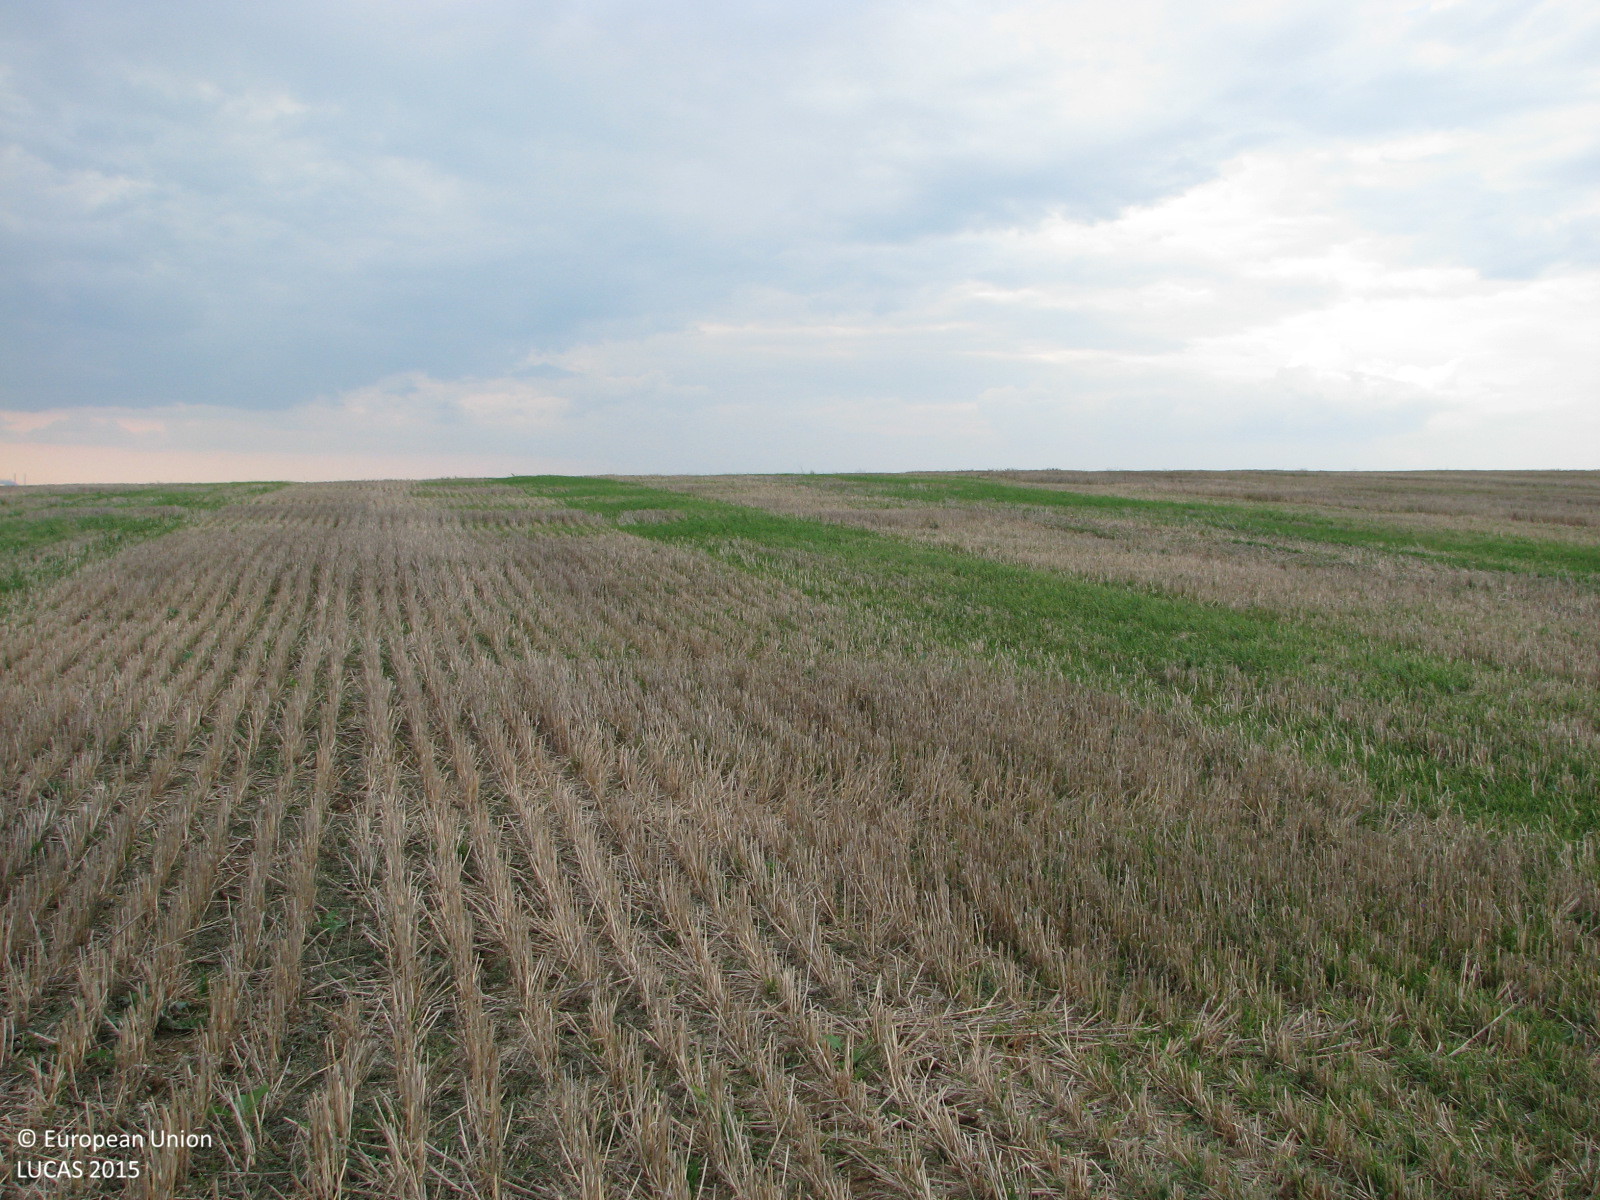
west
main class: Cropland
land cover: Common wheat
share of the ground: > 75 %
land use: Agriculture (excluding fallow land and kitchen gardens)
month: October
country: BG
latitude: 42.2739
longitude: 26.4446
